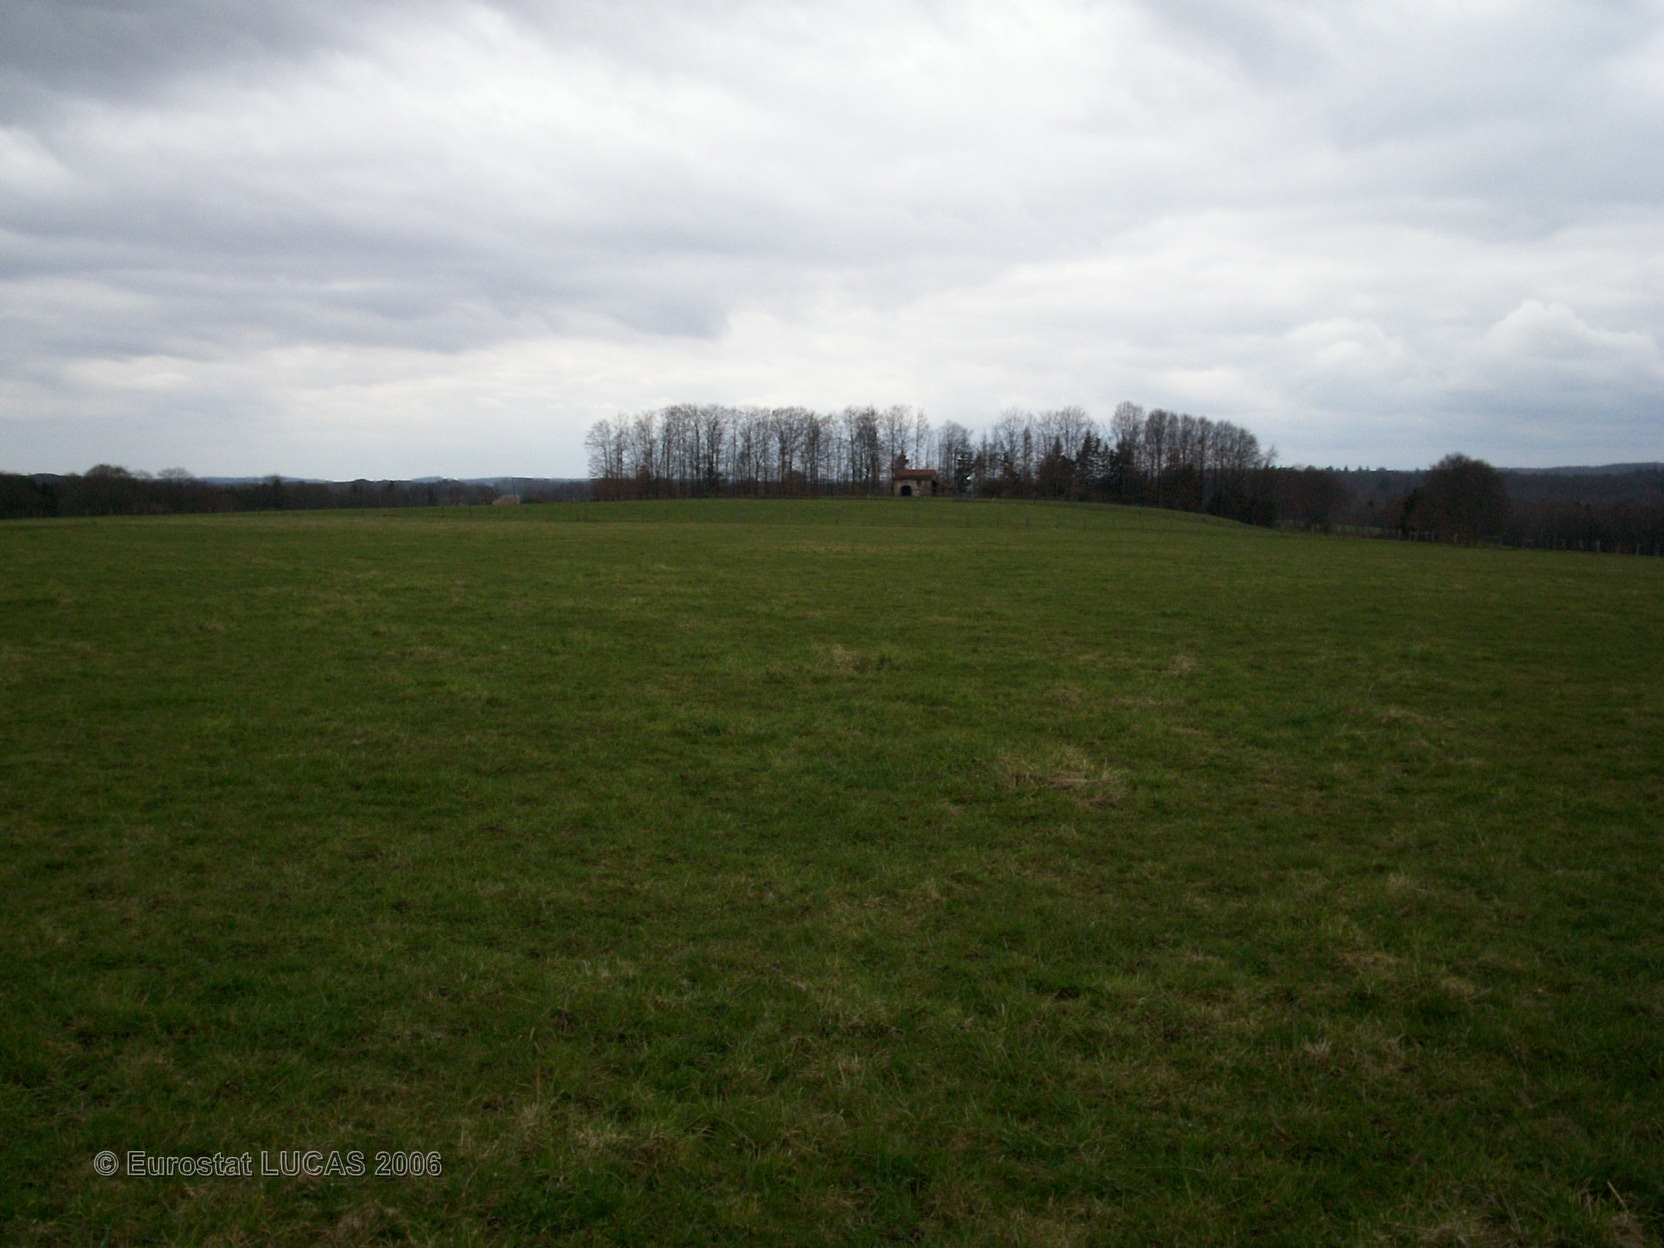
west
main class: Grassland
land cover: Grassland without tree/shrub cover
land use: Agriculture (excluding fallow land and kitchen gardens)
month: April
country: FR
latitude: 48.0060
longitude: 6.5025
